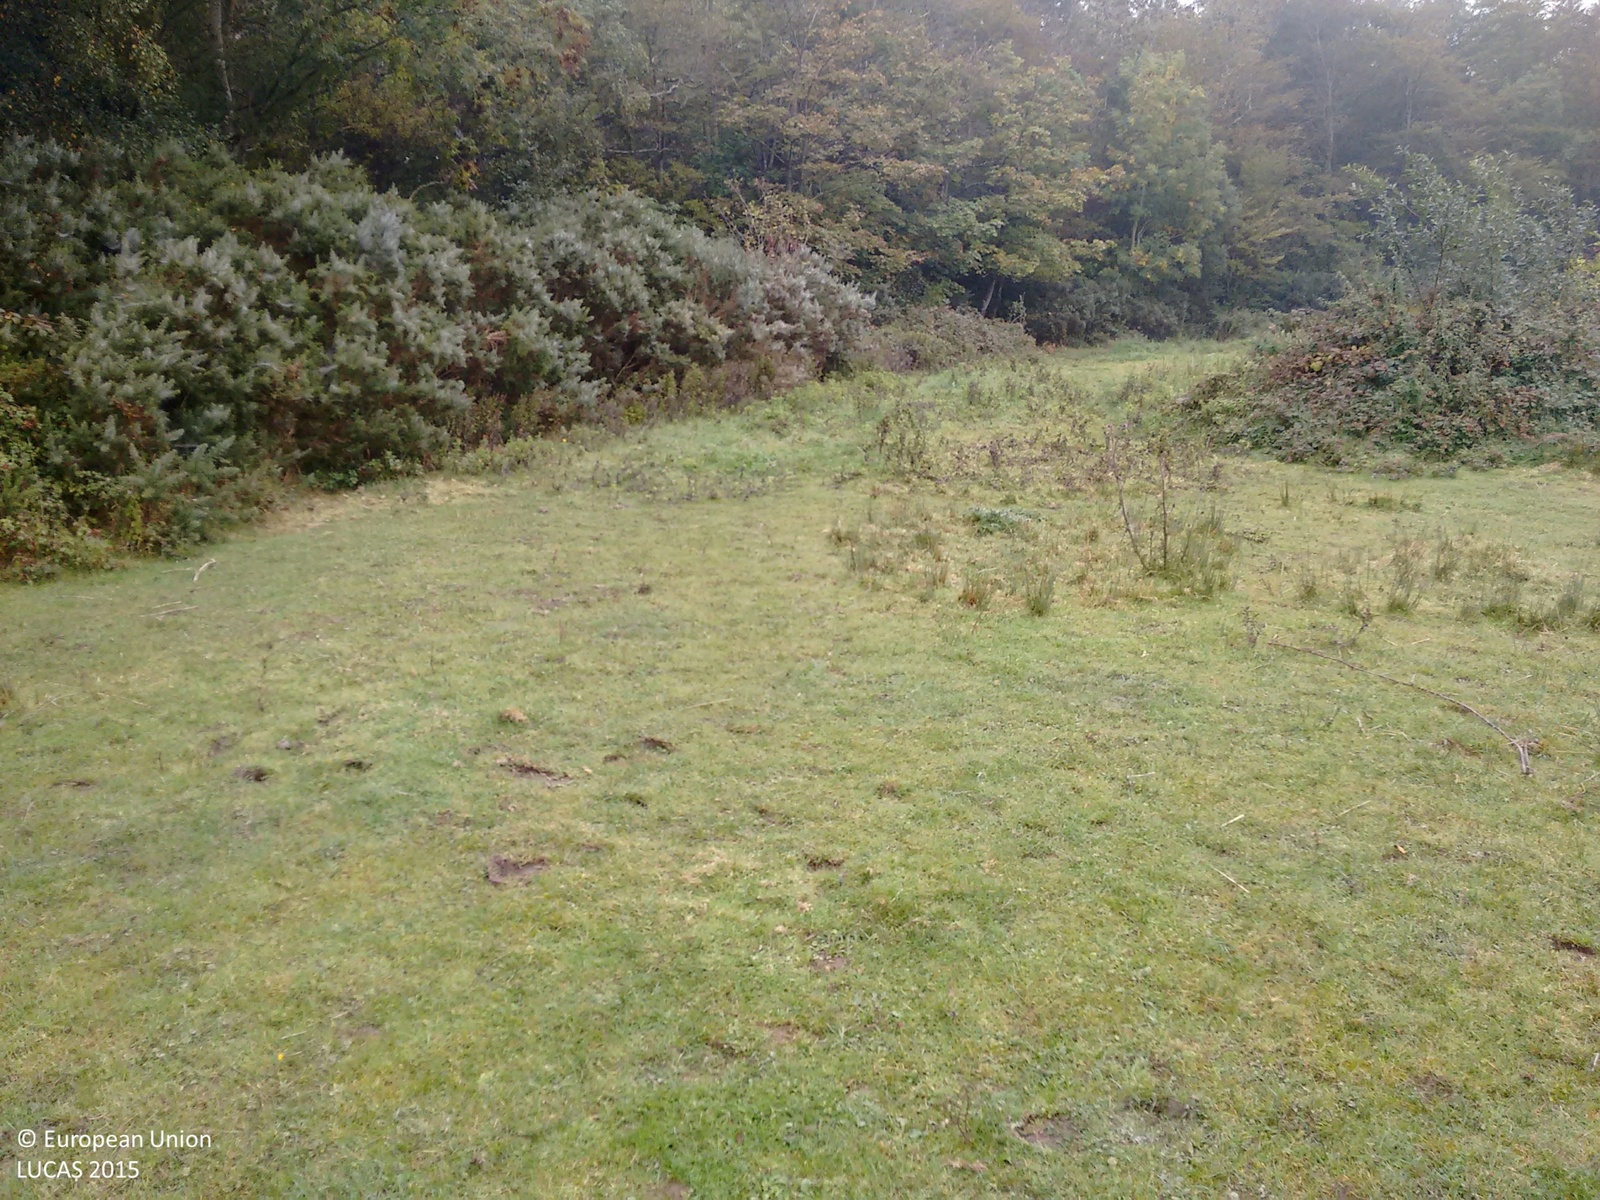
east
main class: Grassland
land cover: Grassland without tree/shrub cover
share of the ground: > 75 %
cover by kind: herbaceous plants 75 %, shrubs 5 %
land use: Agriculture (excluding fallow land and kitchen gardens)
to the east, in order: Grassland without tree/shrub cover; Broadleaved woodland; Grassland without tree/shrub cover; Abandoned hedges; Grassland without tree/shrub cover
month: October
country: IE
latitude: 52.4541
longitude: -8.9742
